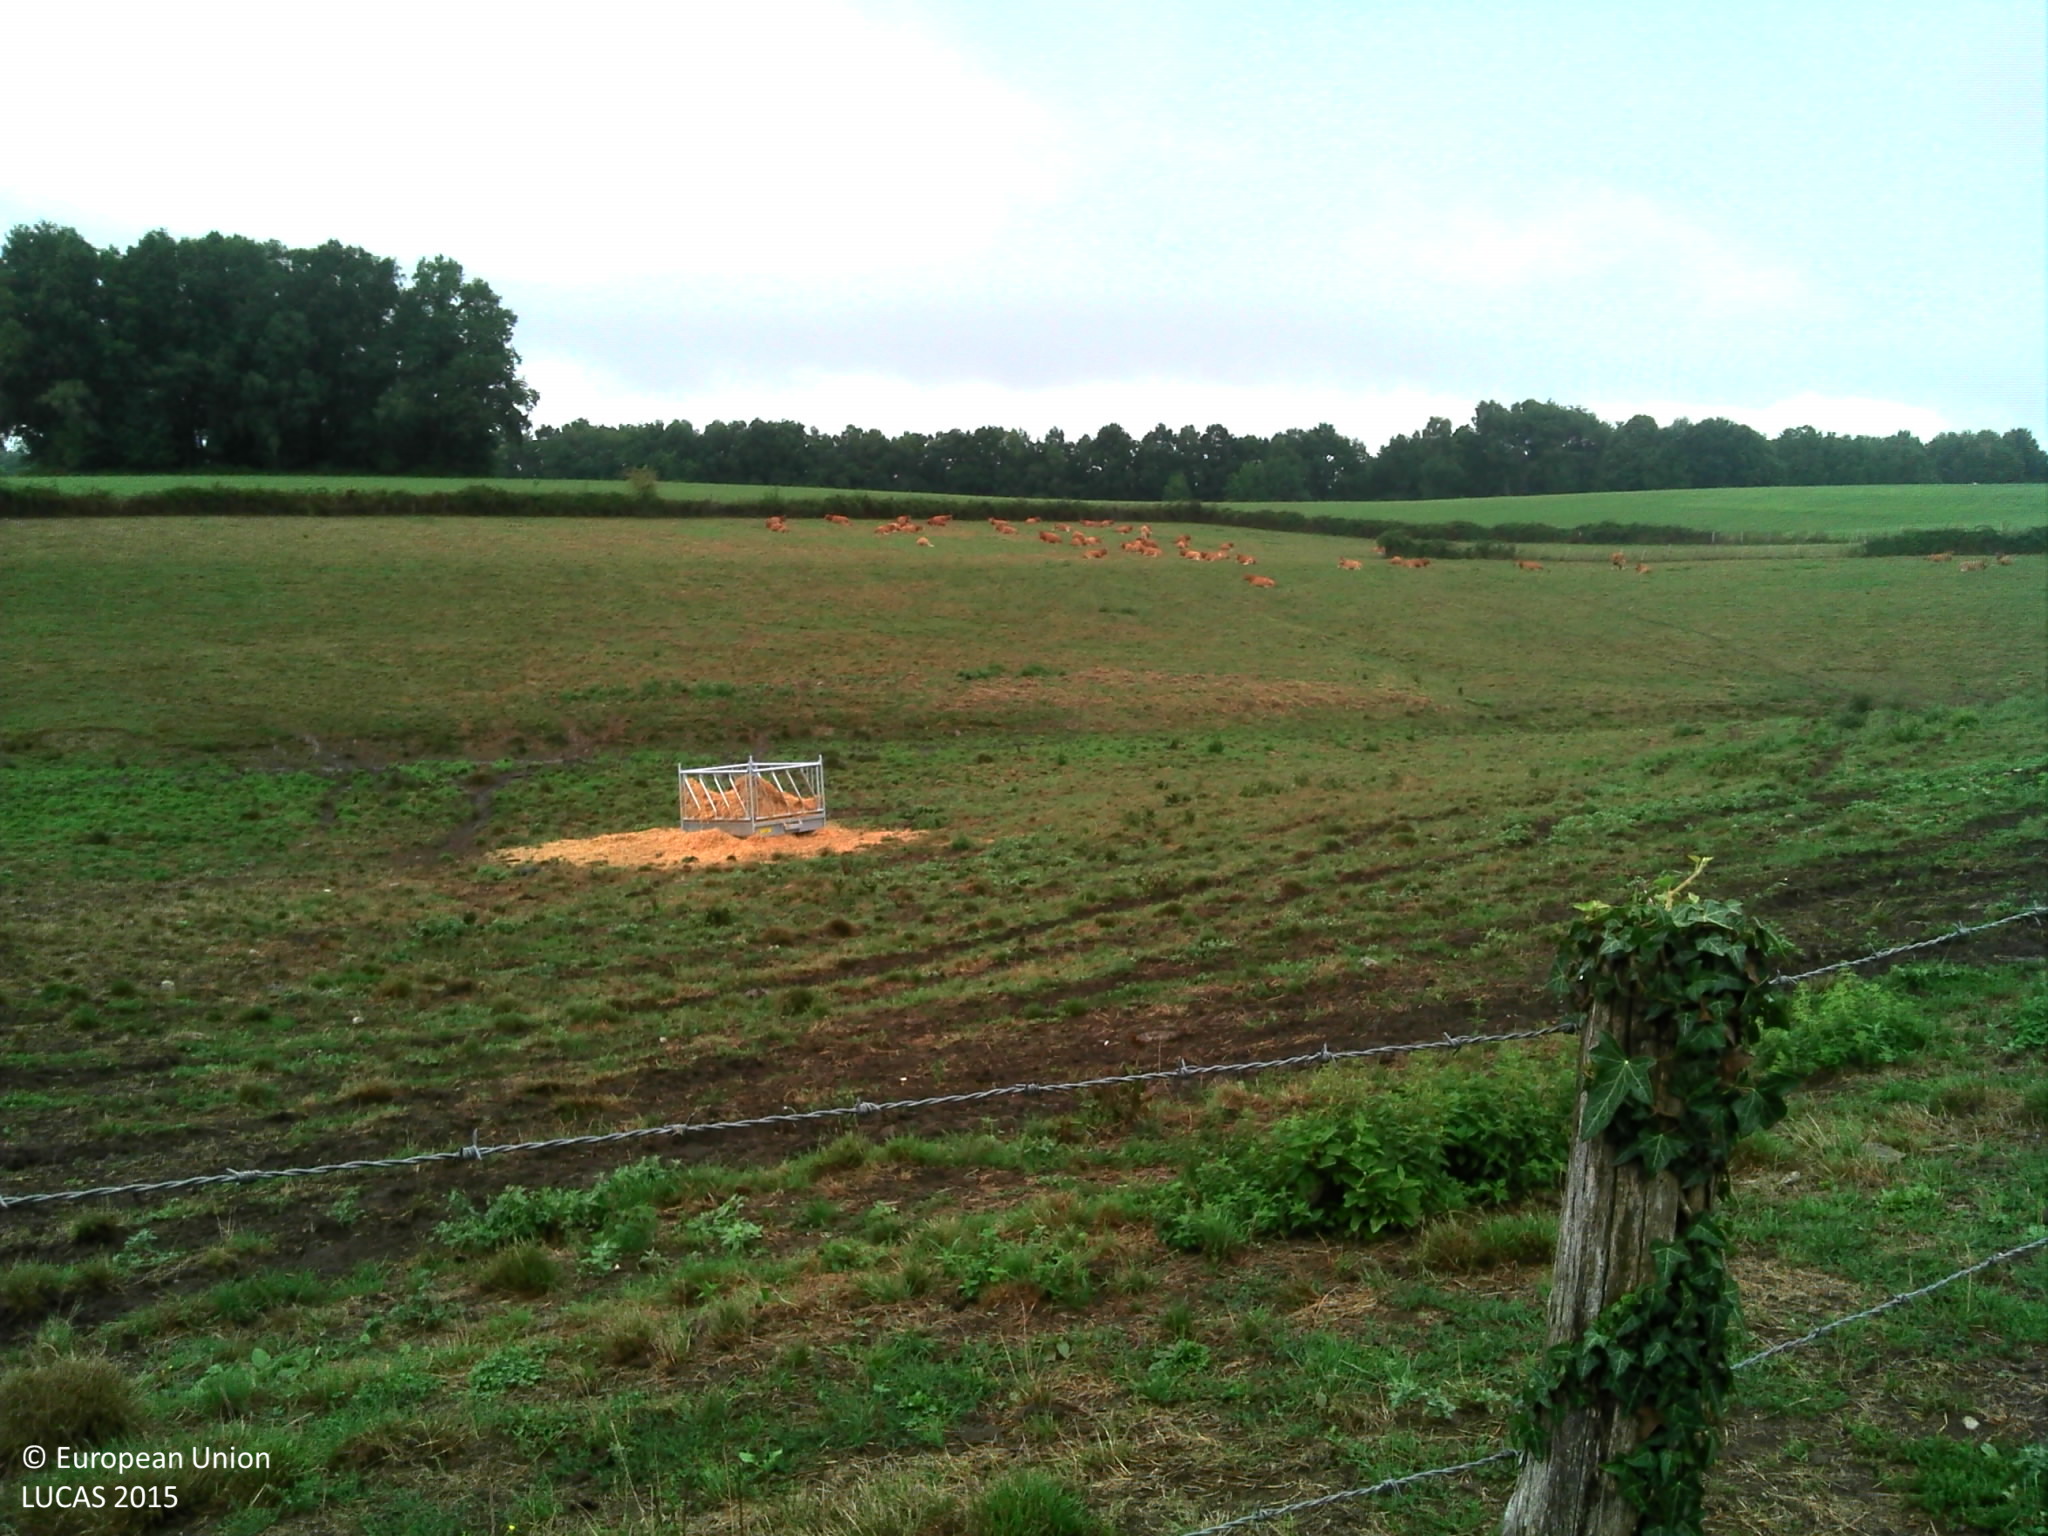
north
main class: Cropland
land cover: Temporary grasslands
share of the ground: > 75 %
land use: Agriculture (excluding fallow land and kitchen gardens)
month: August
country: FR
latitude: 45.5195
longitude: 1.0163
